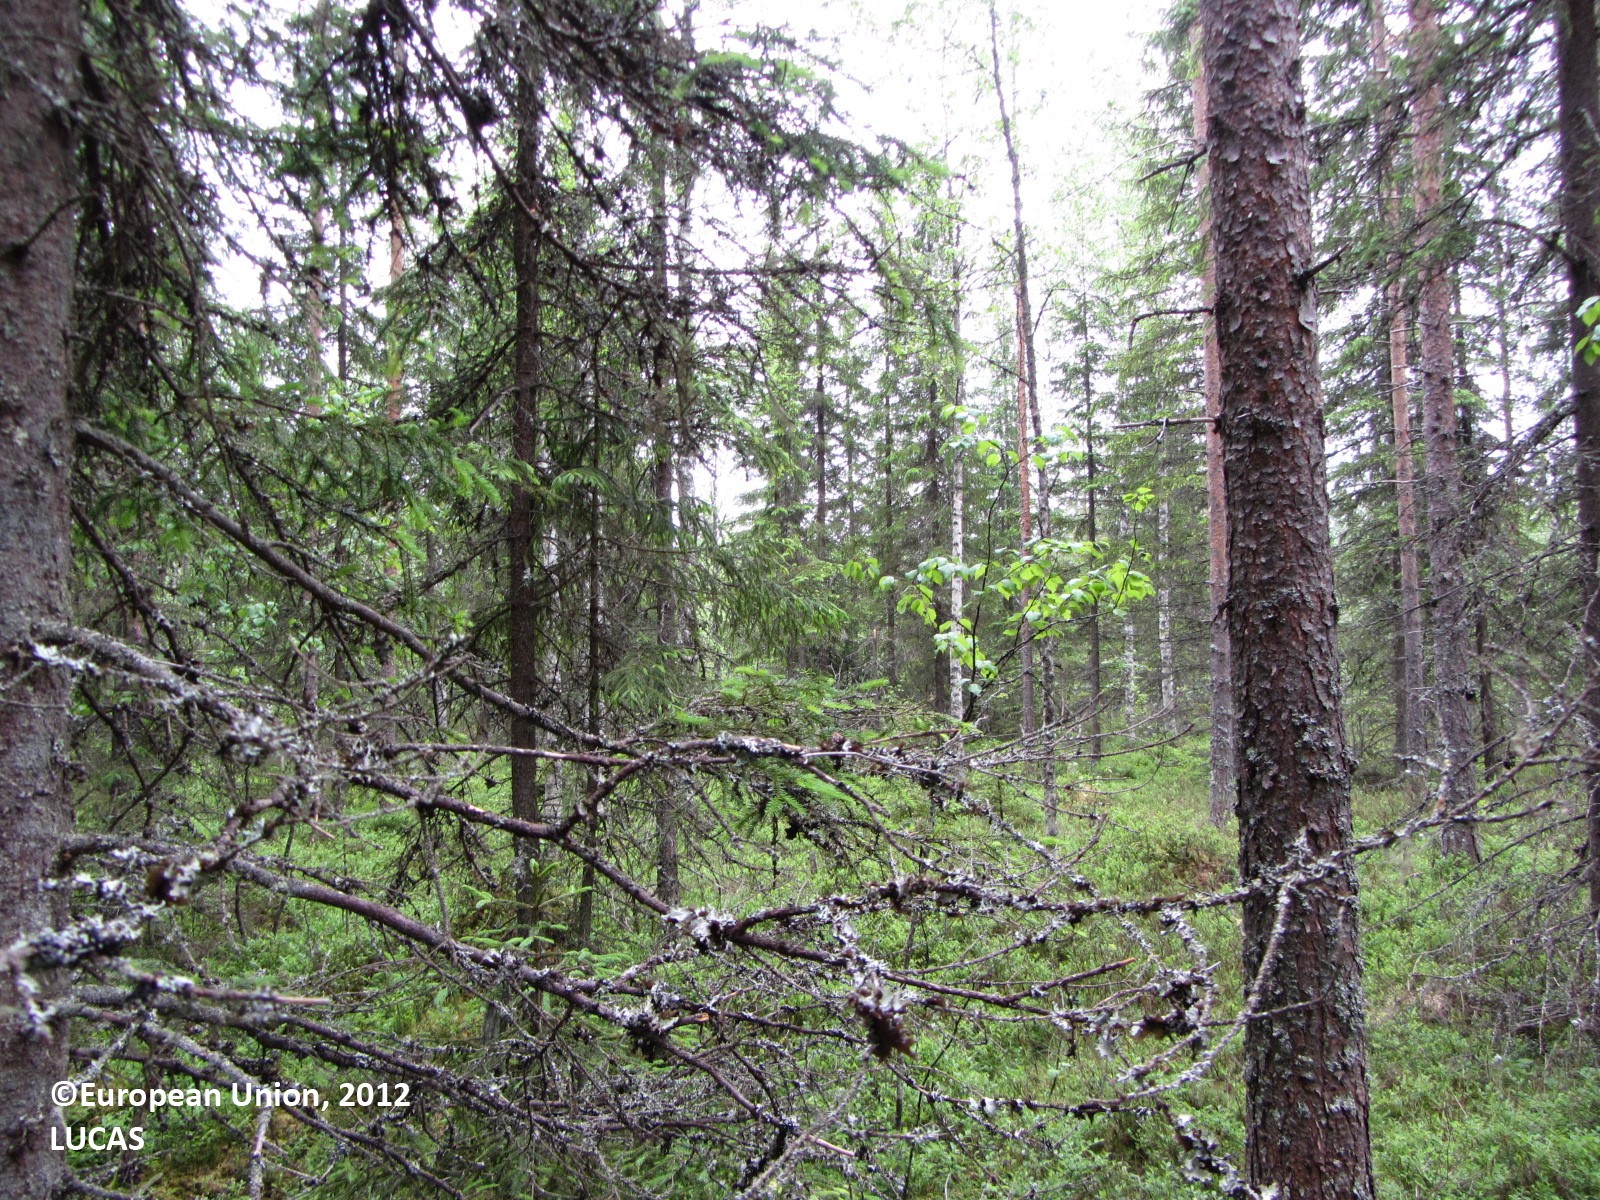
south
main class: Woodland
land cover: Spruce dominated mixed woodland
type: boreal forest
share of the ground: 50 - 75 %
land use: Forestry
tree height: > 5 m
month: June
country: FI
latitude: 62.4691
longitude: 24.9344
